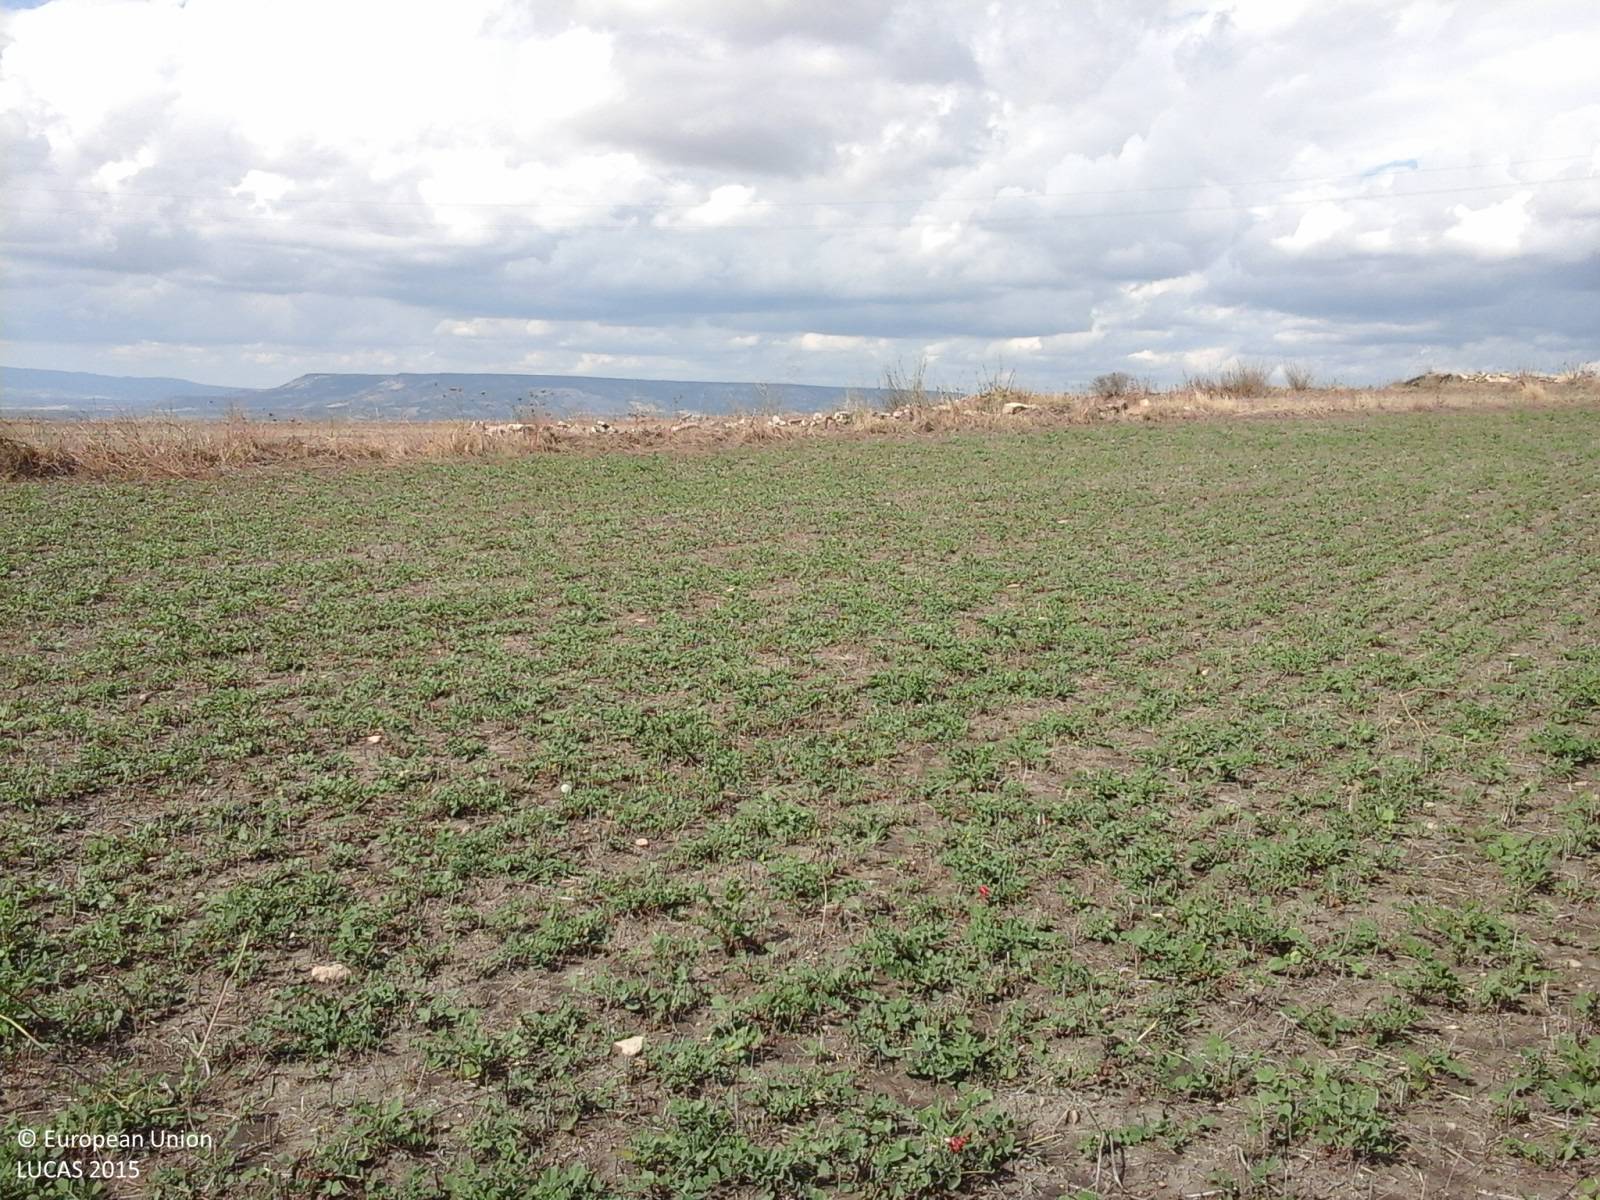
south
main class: Grassland
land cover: Spontaneously vegetated surfaces
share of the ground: > 75 %
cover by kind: herbaceous plants 100 %
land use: Agriculture (excluding fallow land and kitchen gardens)
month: September
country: IT
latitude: 39.6474
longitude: 9.0847
